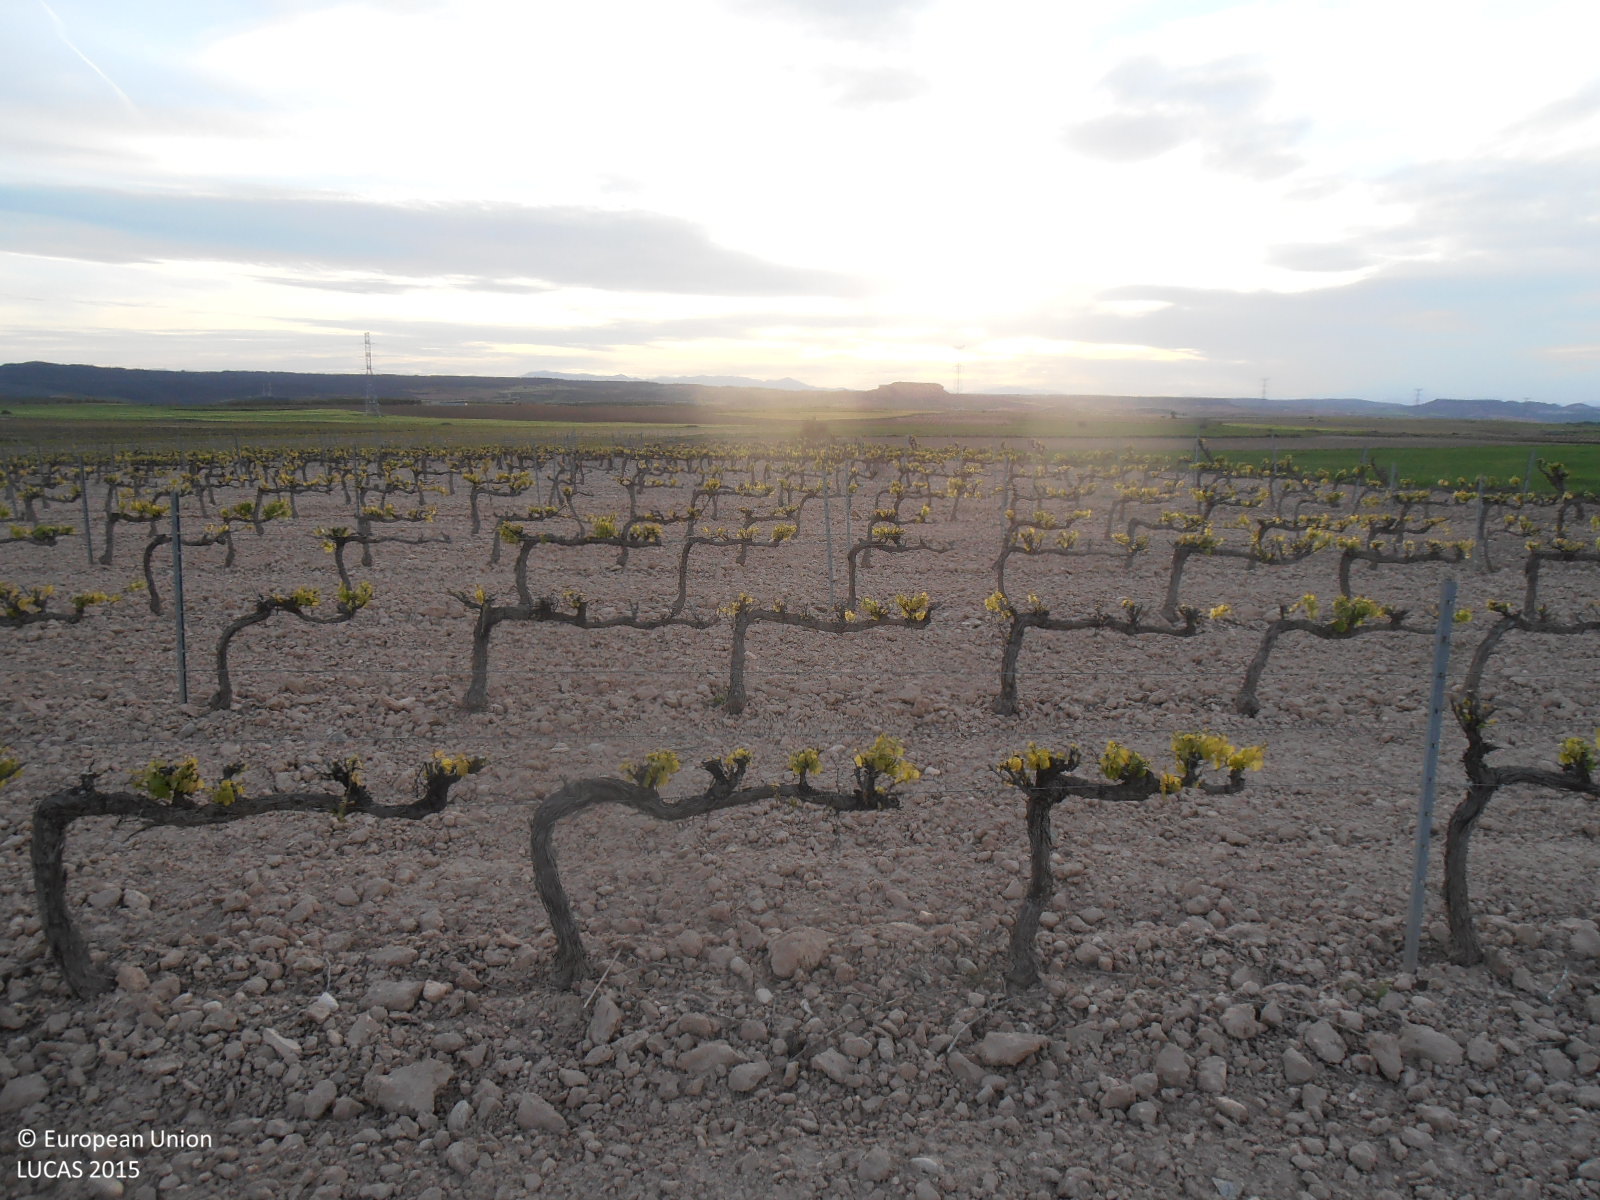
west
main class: Cropland
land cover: Vineyards
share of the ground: 10 - 25 %
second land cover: Other bare soil
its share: > 75 %
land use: Agriculture (excluding fallow land and kitchen gardens)
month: April
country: ES
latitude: 41.3602
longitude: -1.0056
